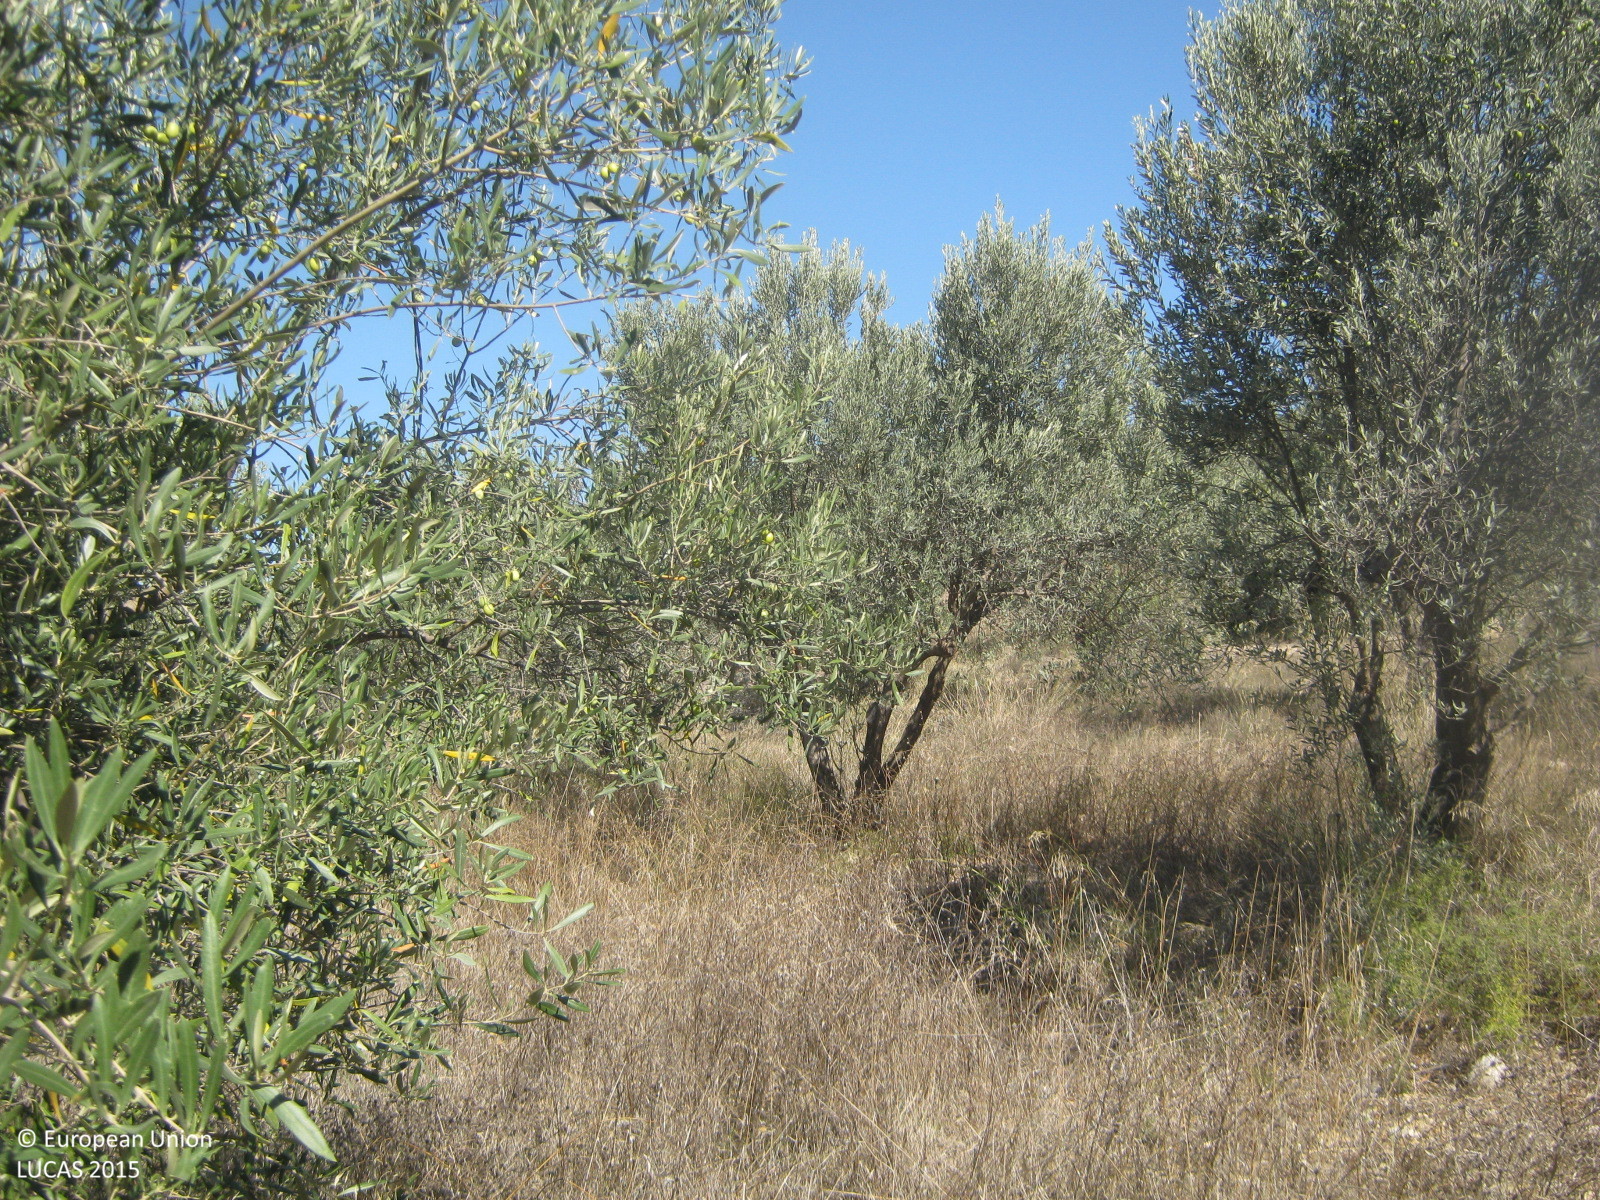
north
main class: Cropland
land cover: Olive groves
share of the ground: > 75 %
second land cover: Spontaneously vegetated surfaces
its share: 25 - 50 %
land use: Agriculture (excluding fallow land and kitchen gardens)
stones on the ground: 10 - 25 %
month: October
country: GR
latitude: 37.7221
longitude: 22.7994
